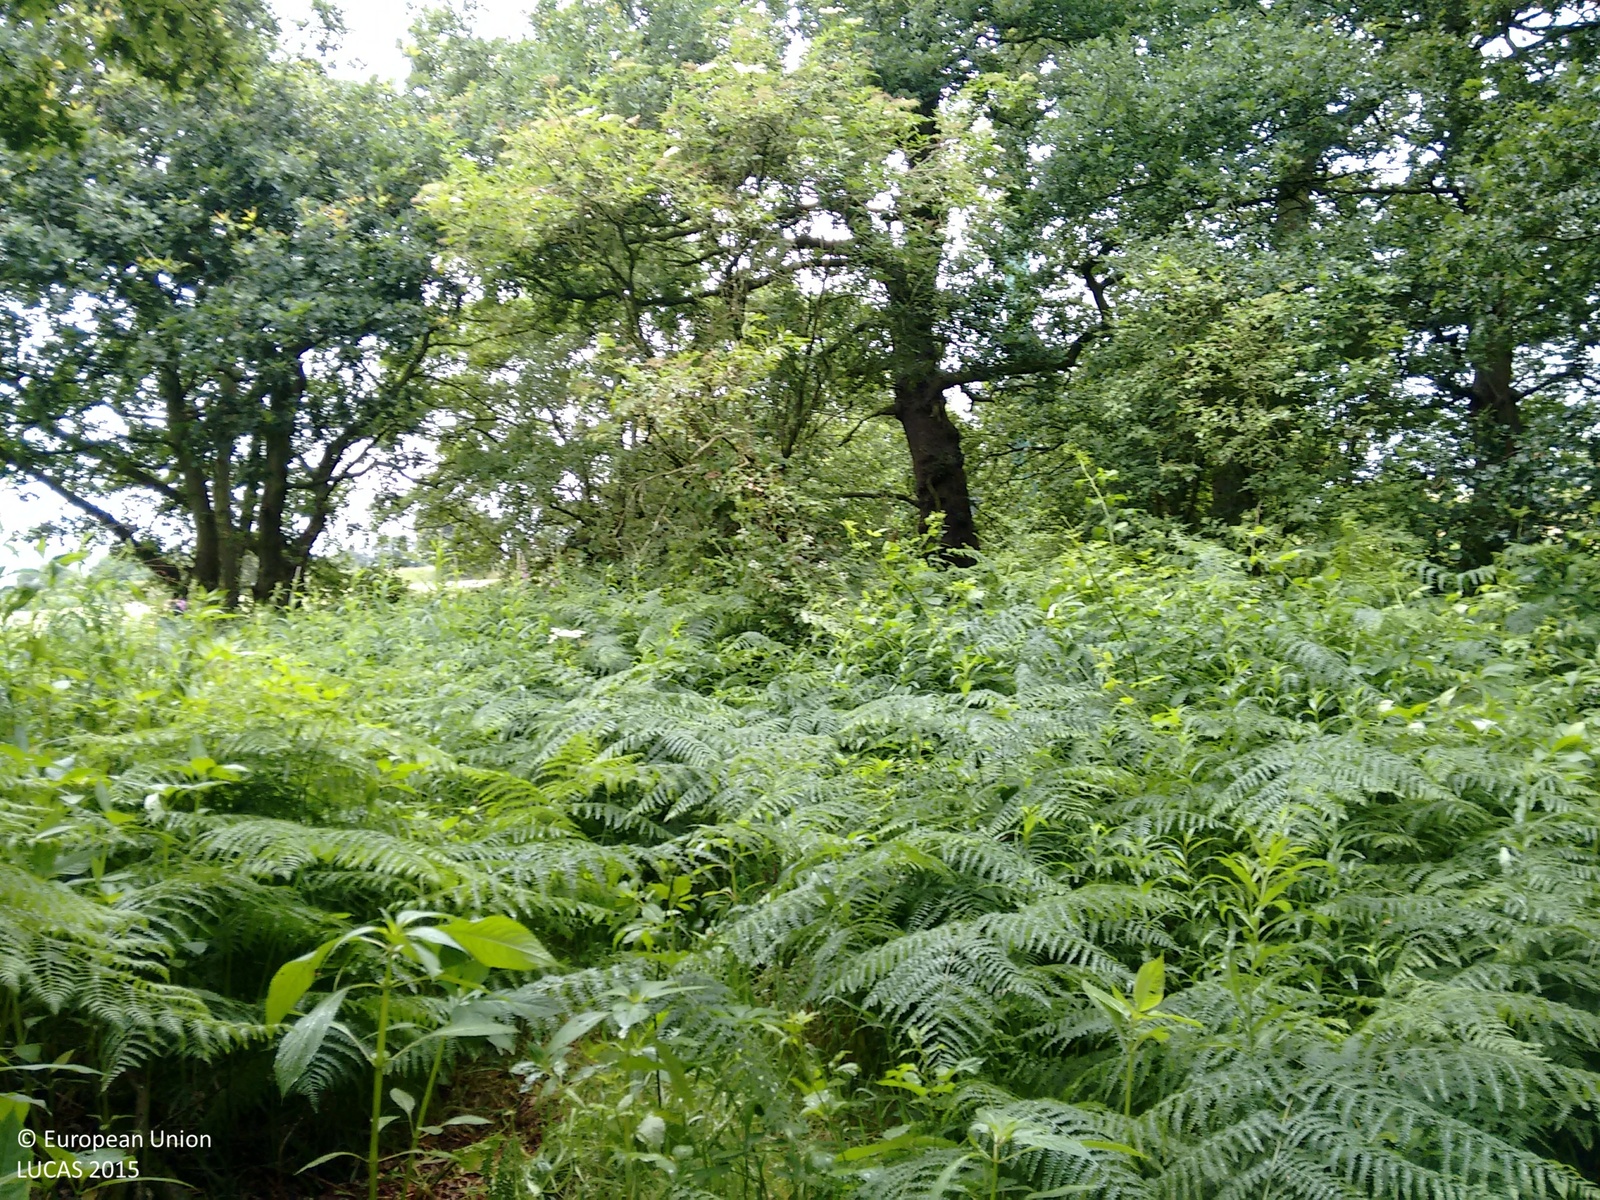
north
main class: Woodland
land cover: Broadleaved woodland
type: mesophytic deciduous forest
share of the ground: > 75 %
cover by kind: broadleaved forest trees 100 %
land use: Semi-natural and natural areas not in use
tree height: > 5 m
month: July
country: GB
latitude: 53.3943
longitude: -2.4409
